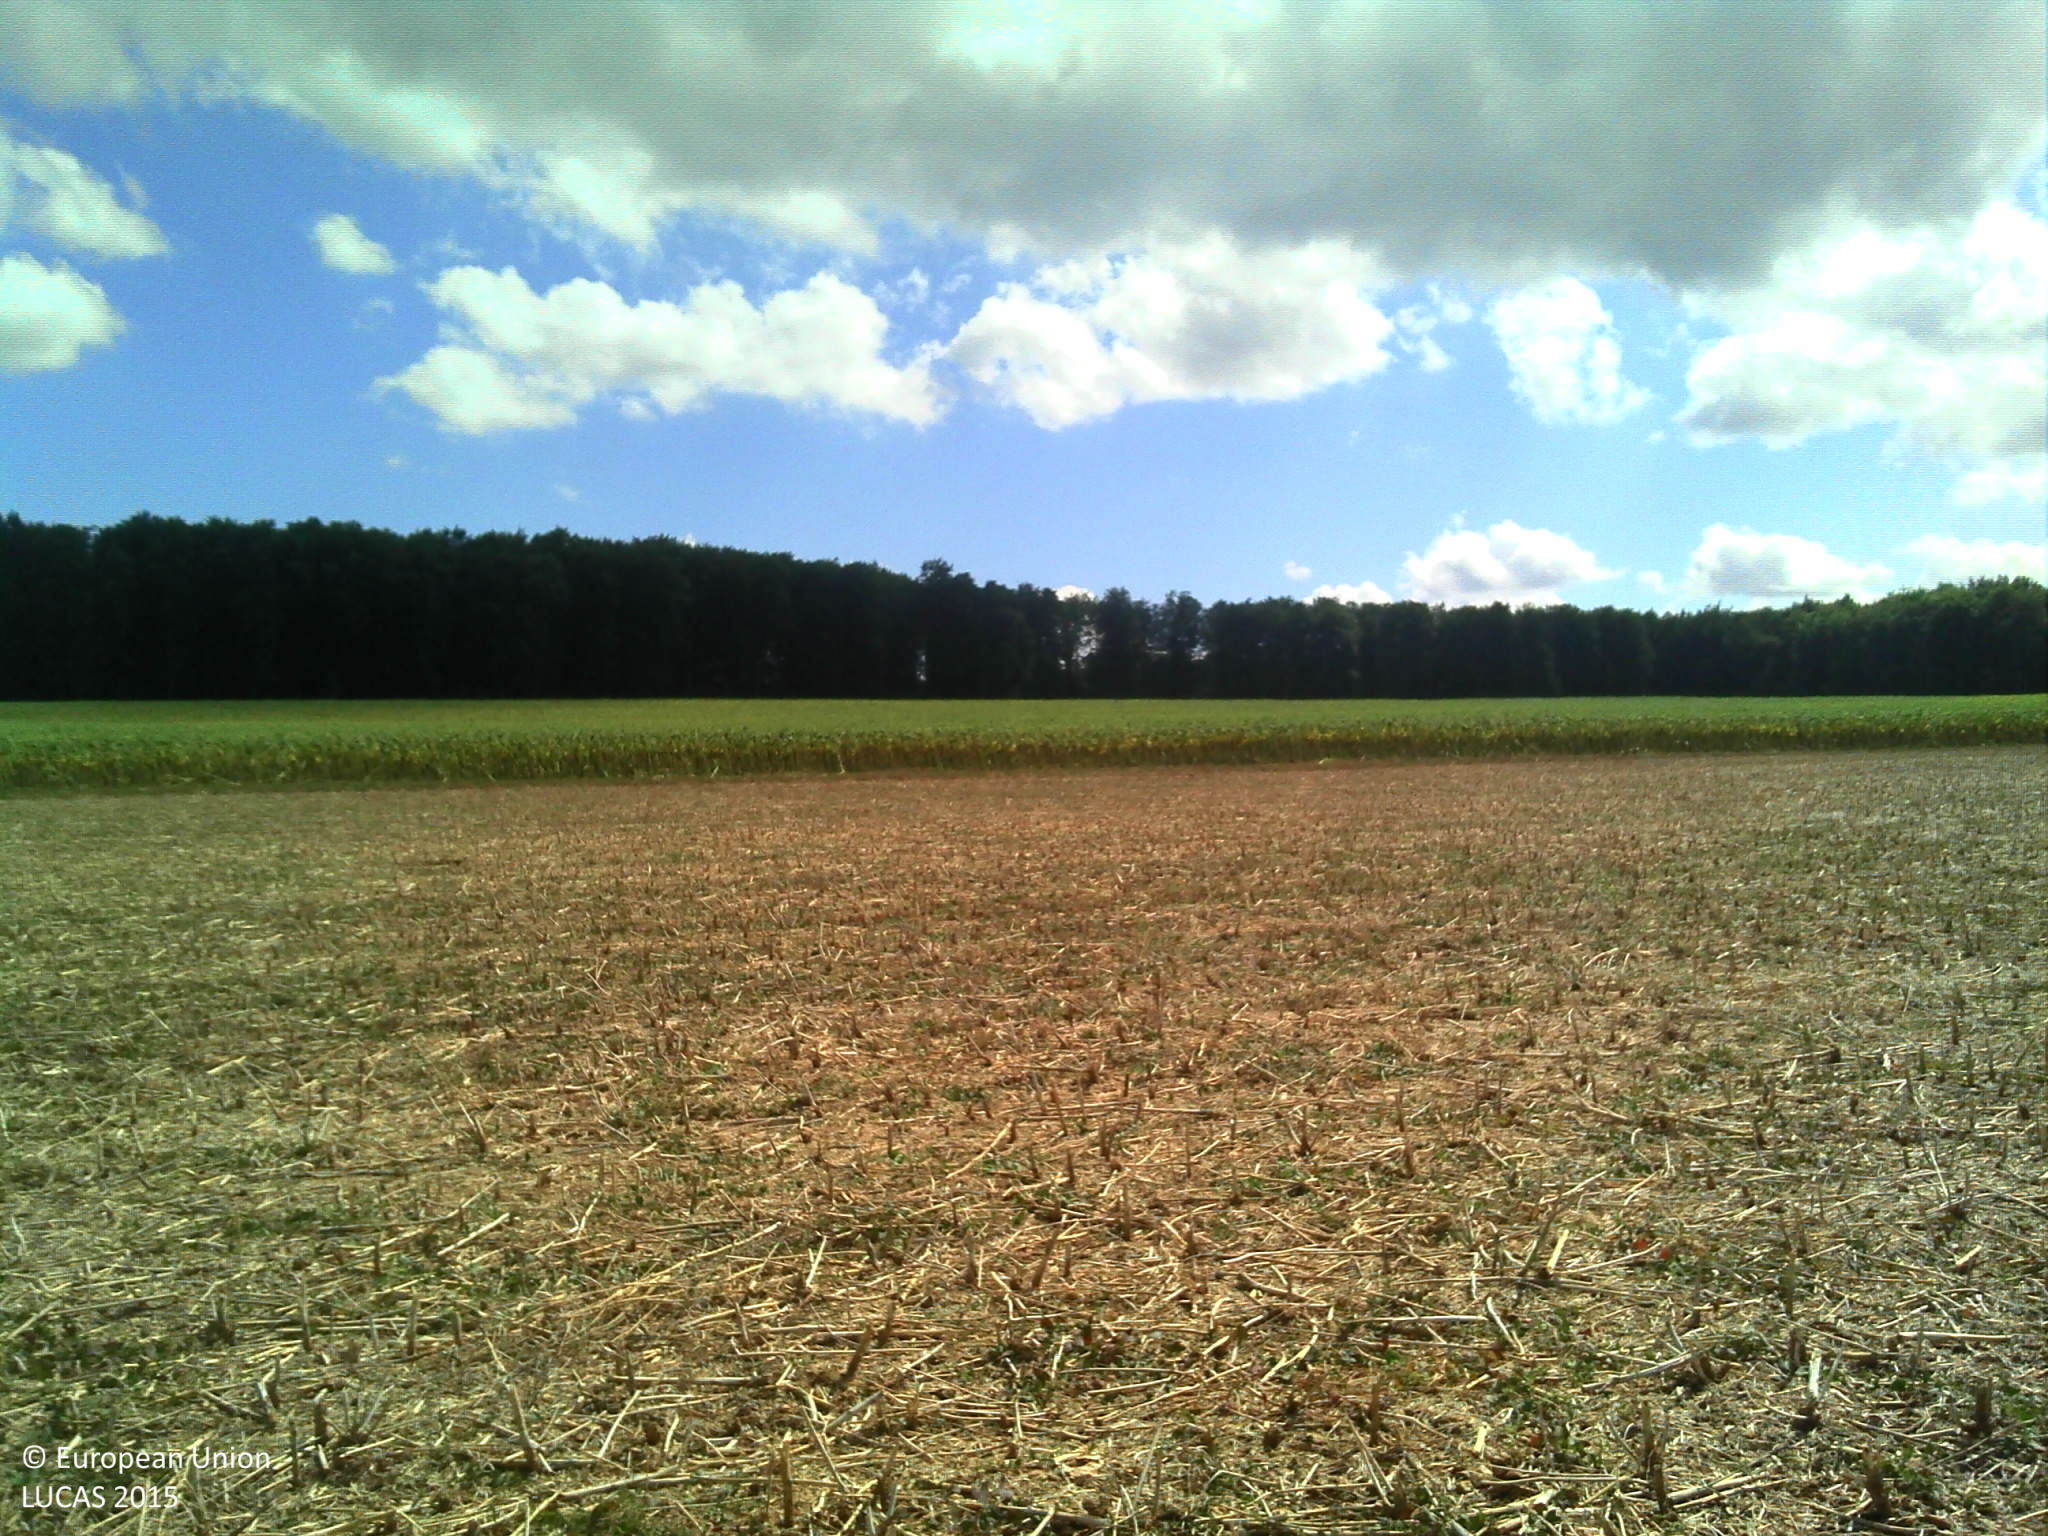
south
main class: Cropland
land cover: Rape and turnip rape
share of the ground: 10 - 25 %
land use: Agriculture (excluding fallow land and kitchen gardens)
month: August
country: FR
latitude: 47.7686
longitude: 5.0226
